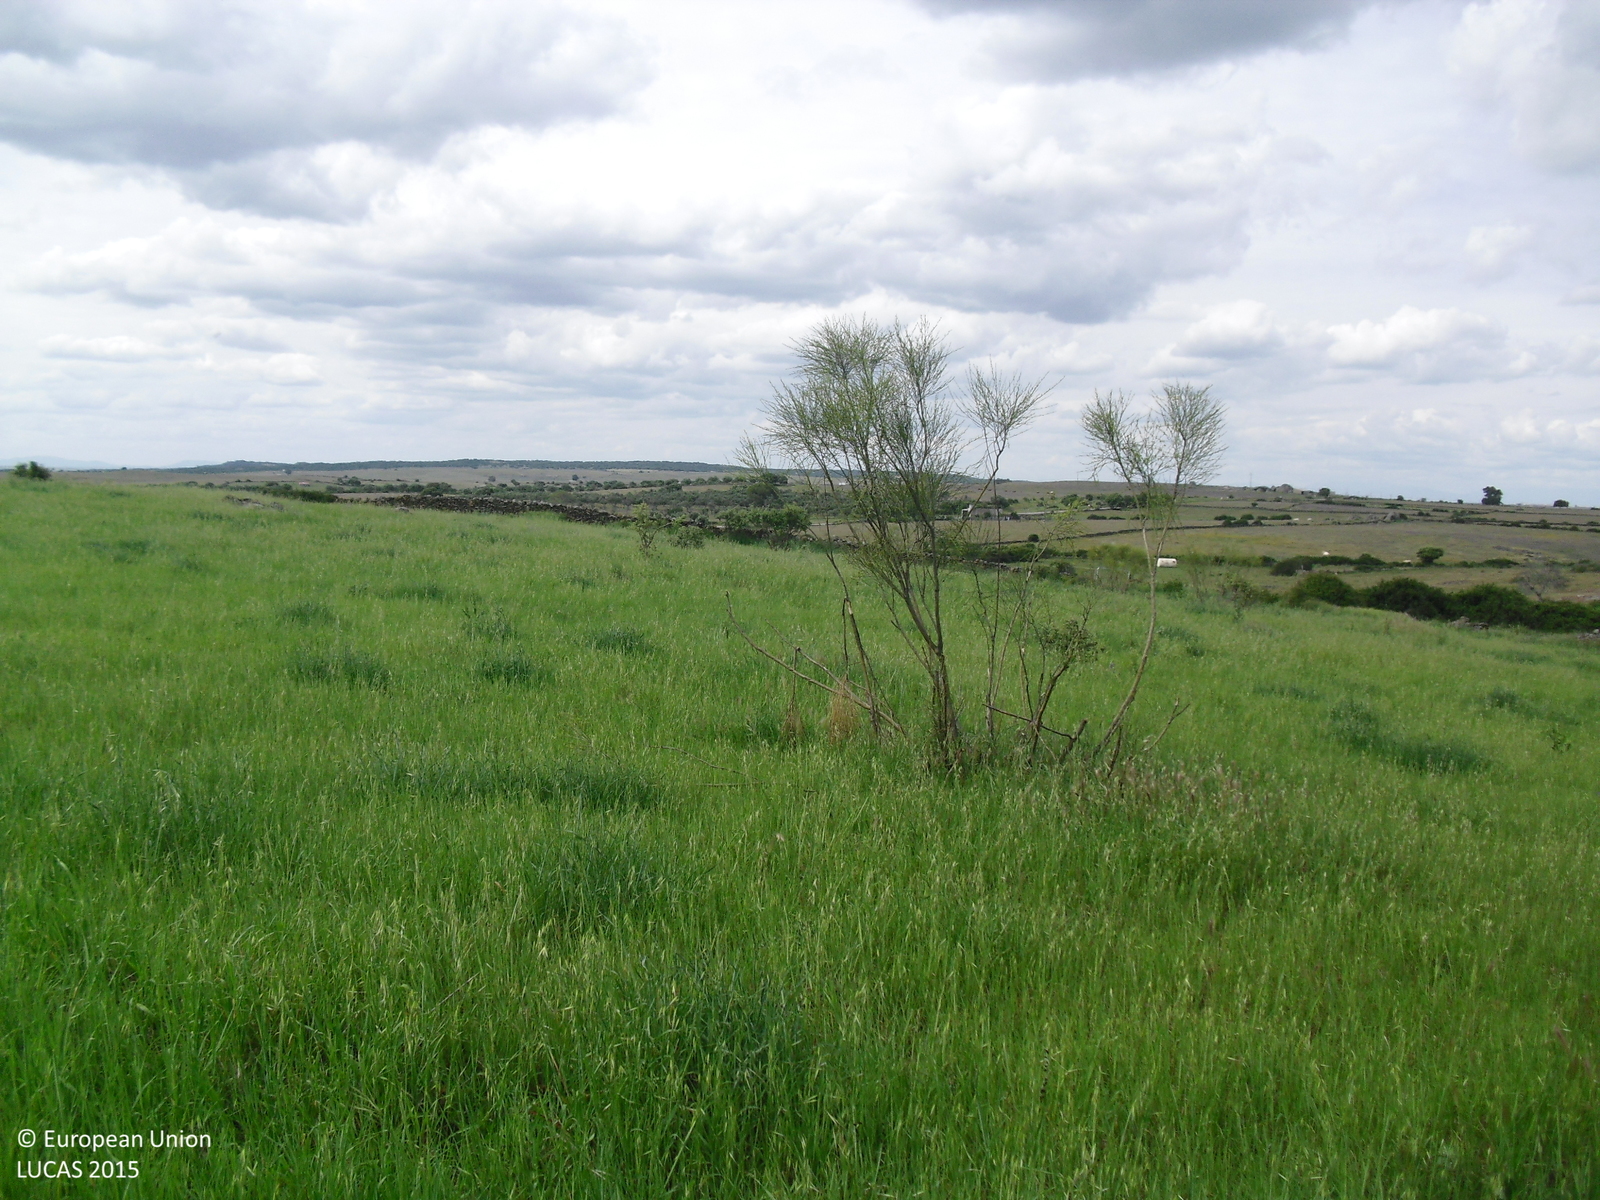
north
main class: Grassland
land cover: Grassland without tree/shrub cover
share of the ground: > 75 %
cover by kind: herbaceous plants 95 %, shrubs 5 %
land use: Agriculture (excluding fallow land and kitchen gardens)
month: April
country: ES
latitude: 39.3296
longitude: -6.0093
